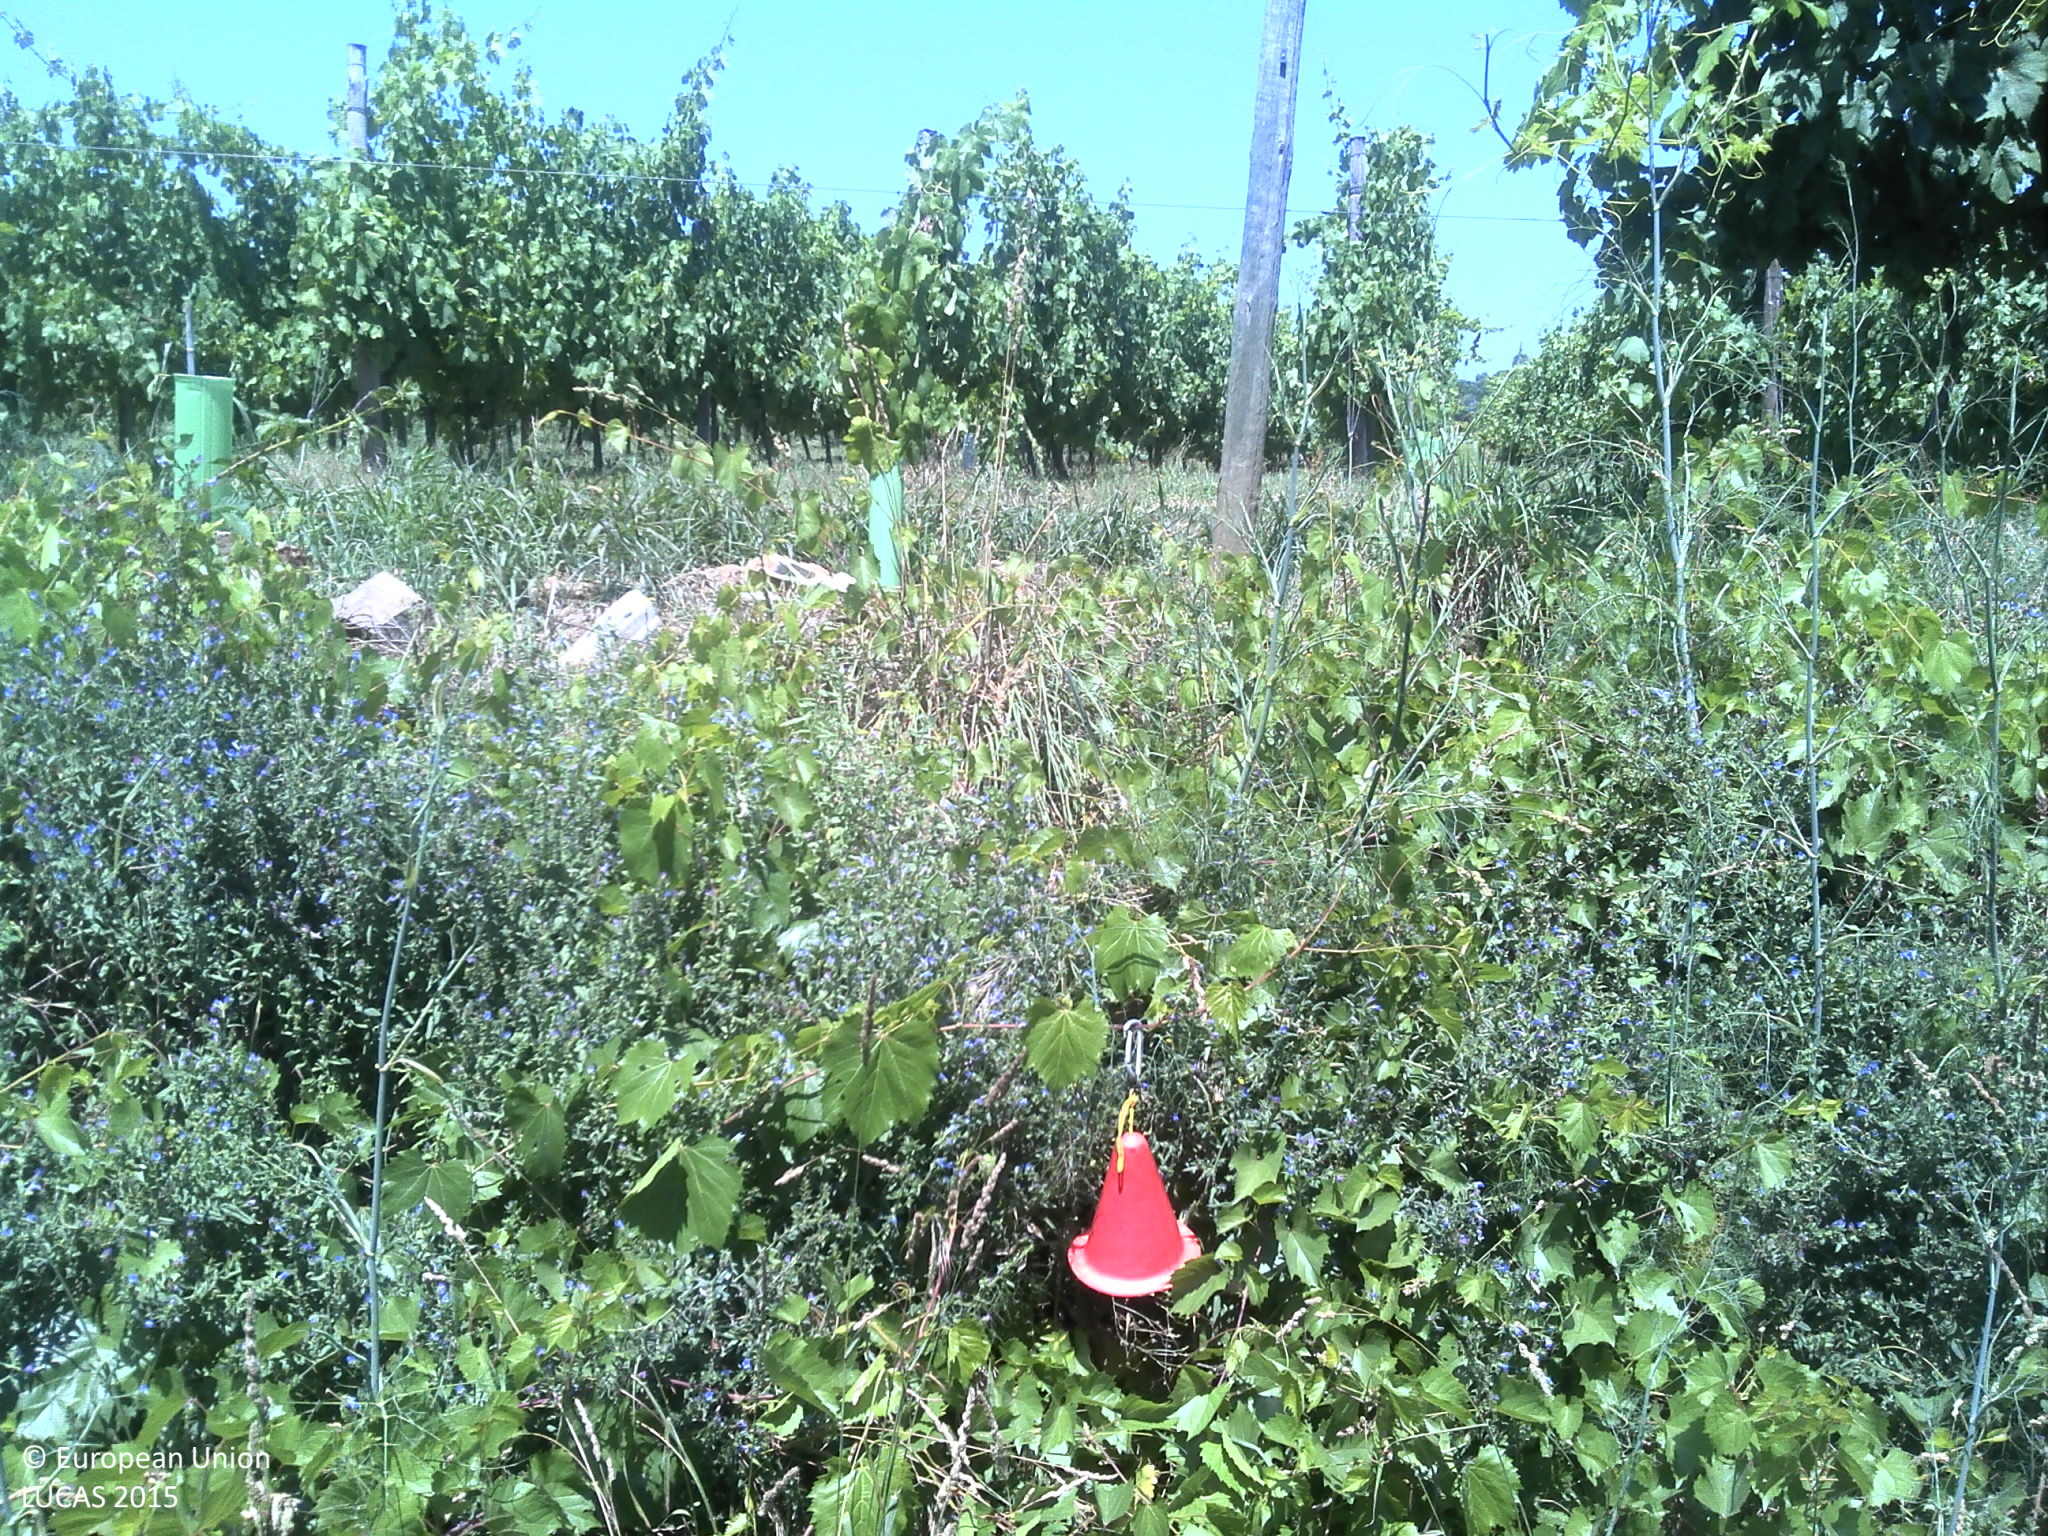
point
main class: Shrubland
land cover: Shrubland without tree cover
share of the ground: > 75 %
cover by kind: shrubs 75 %, consolidated bare surface 15 %, herbaceous plants 10 %
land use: Road transport
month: June
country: PT
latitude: 41.4174
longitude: -7.9776
